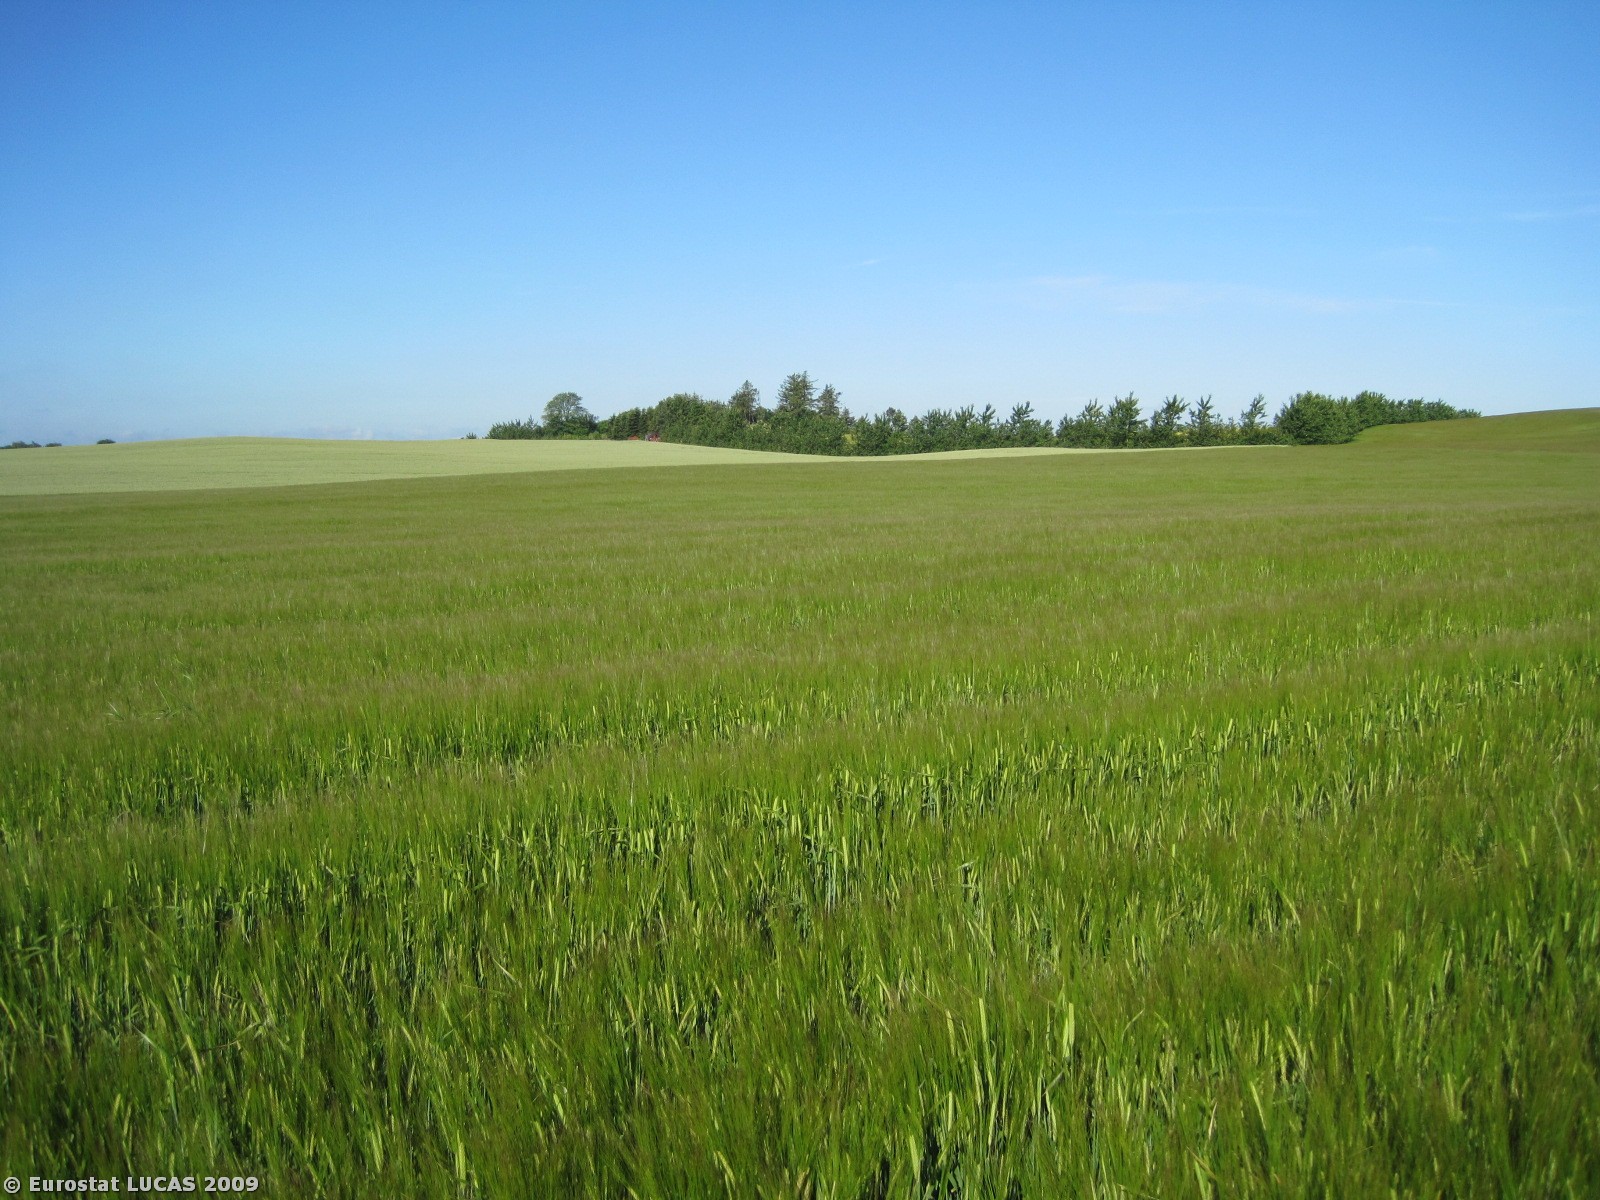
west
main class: Cropland
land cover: Barley
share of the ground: > 75 %
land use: Agriculture (excluding fallow land and kitchen gardens)
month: June
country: DK
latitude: 56.5808
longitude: 9.2033
